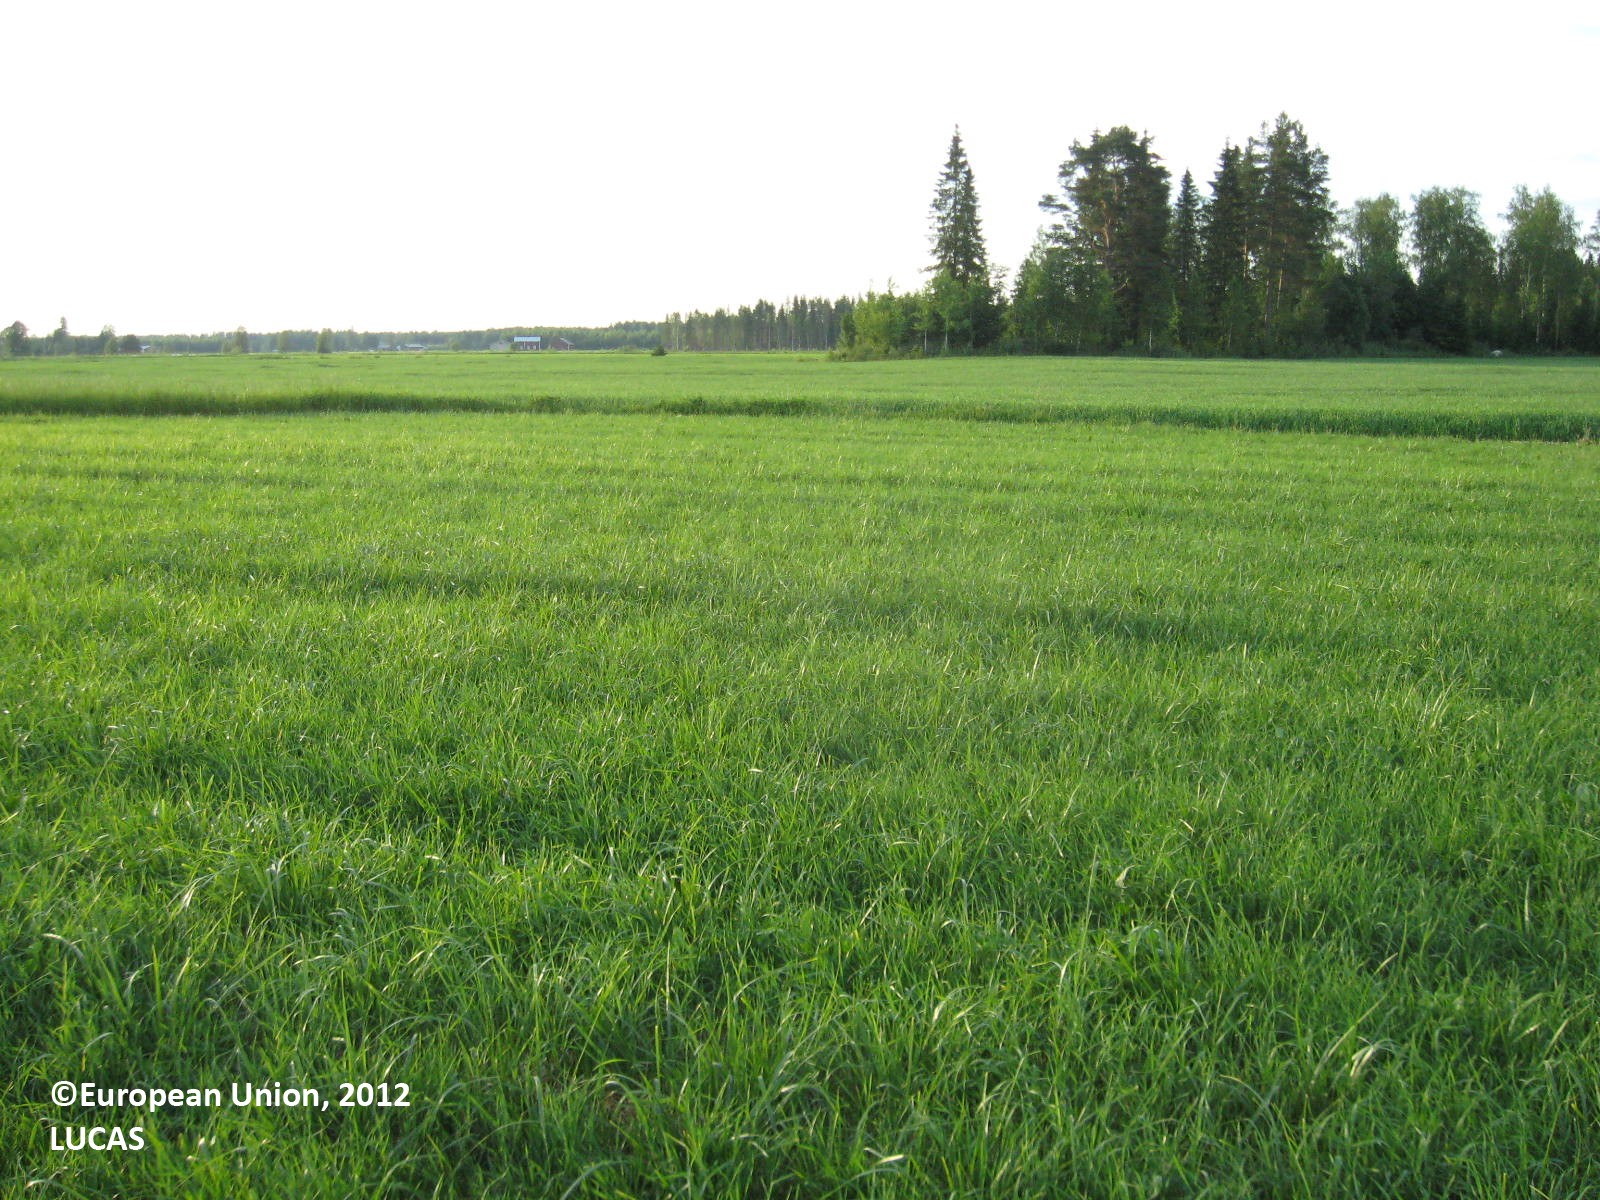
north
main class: Cropland
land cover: Temporary grasslands
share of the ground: > 75 %
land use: Agriculture (excluding fallow land and kitchen gardens)
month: July
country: FI
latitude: 62.5775
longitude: 21.6640
